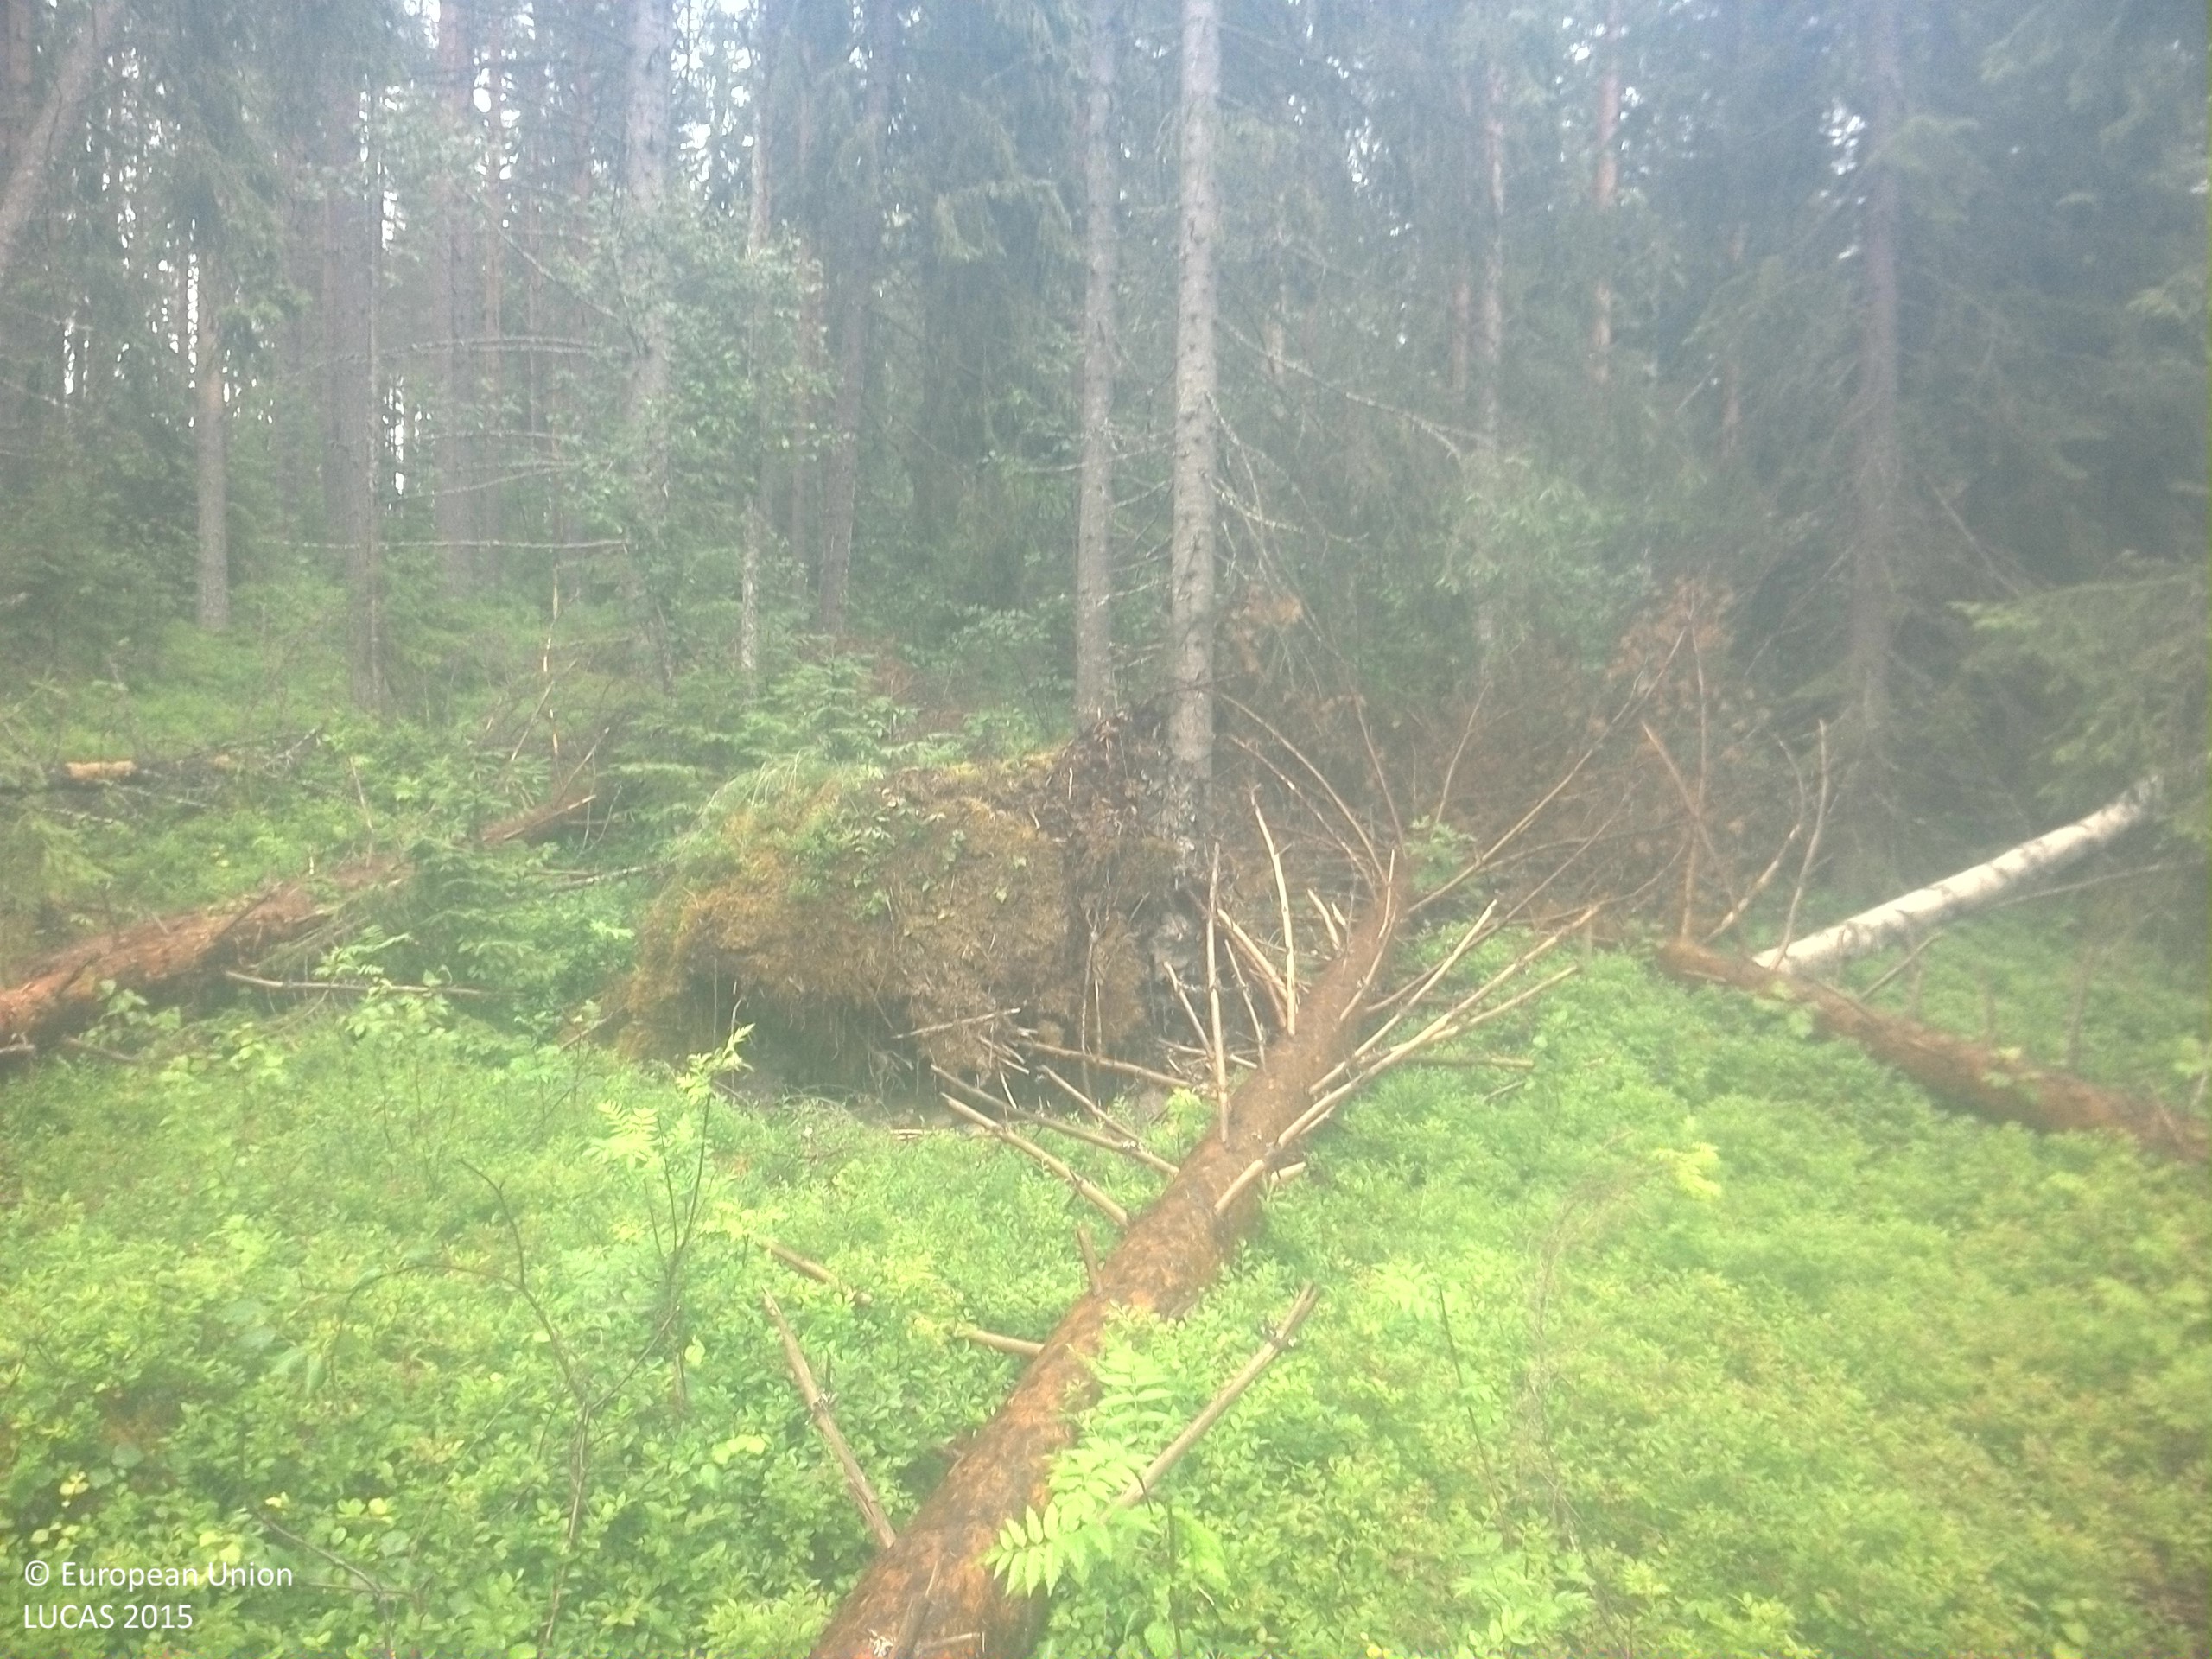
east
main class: Woodland
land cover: Other coniferous woodland
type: boreal forest
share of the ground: 25 - 50 %
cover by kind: coniferous forest trees 40 %, shrubs 40 %, lichens and mosses 10 %, broadleaved forest trees 5 %, herbaceous plants 5 %
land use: Forestry
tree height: > 5 m
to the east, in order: Other coniferous woodland; Shruby margins; Paved roads, cycling and walking lanes; Shruby margins; Other coniferous woodland; Pine dominated coniferous woodland
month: August
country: SE
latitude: 63.5790
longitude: 16.4394
